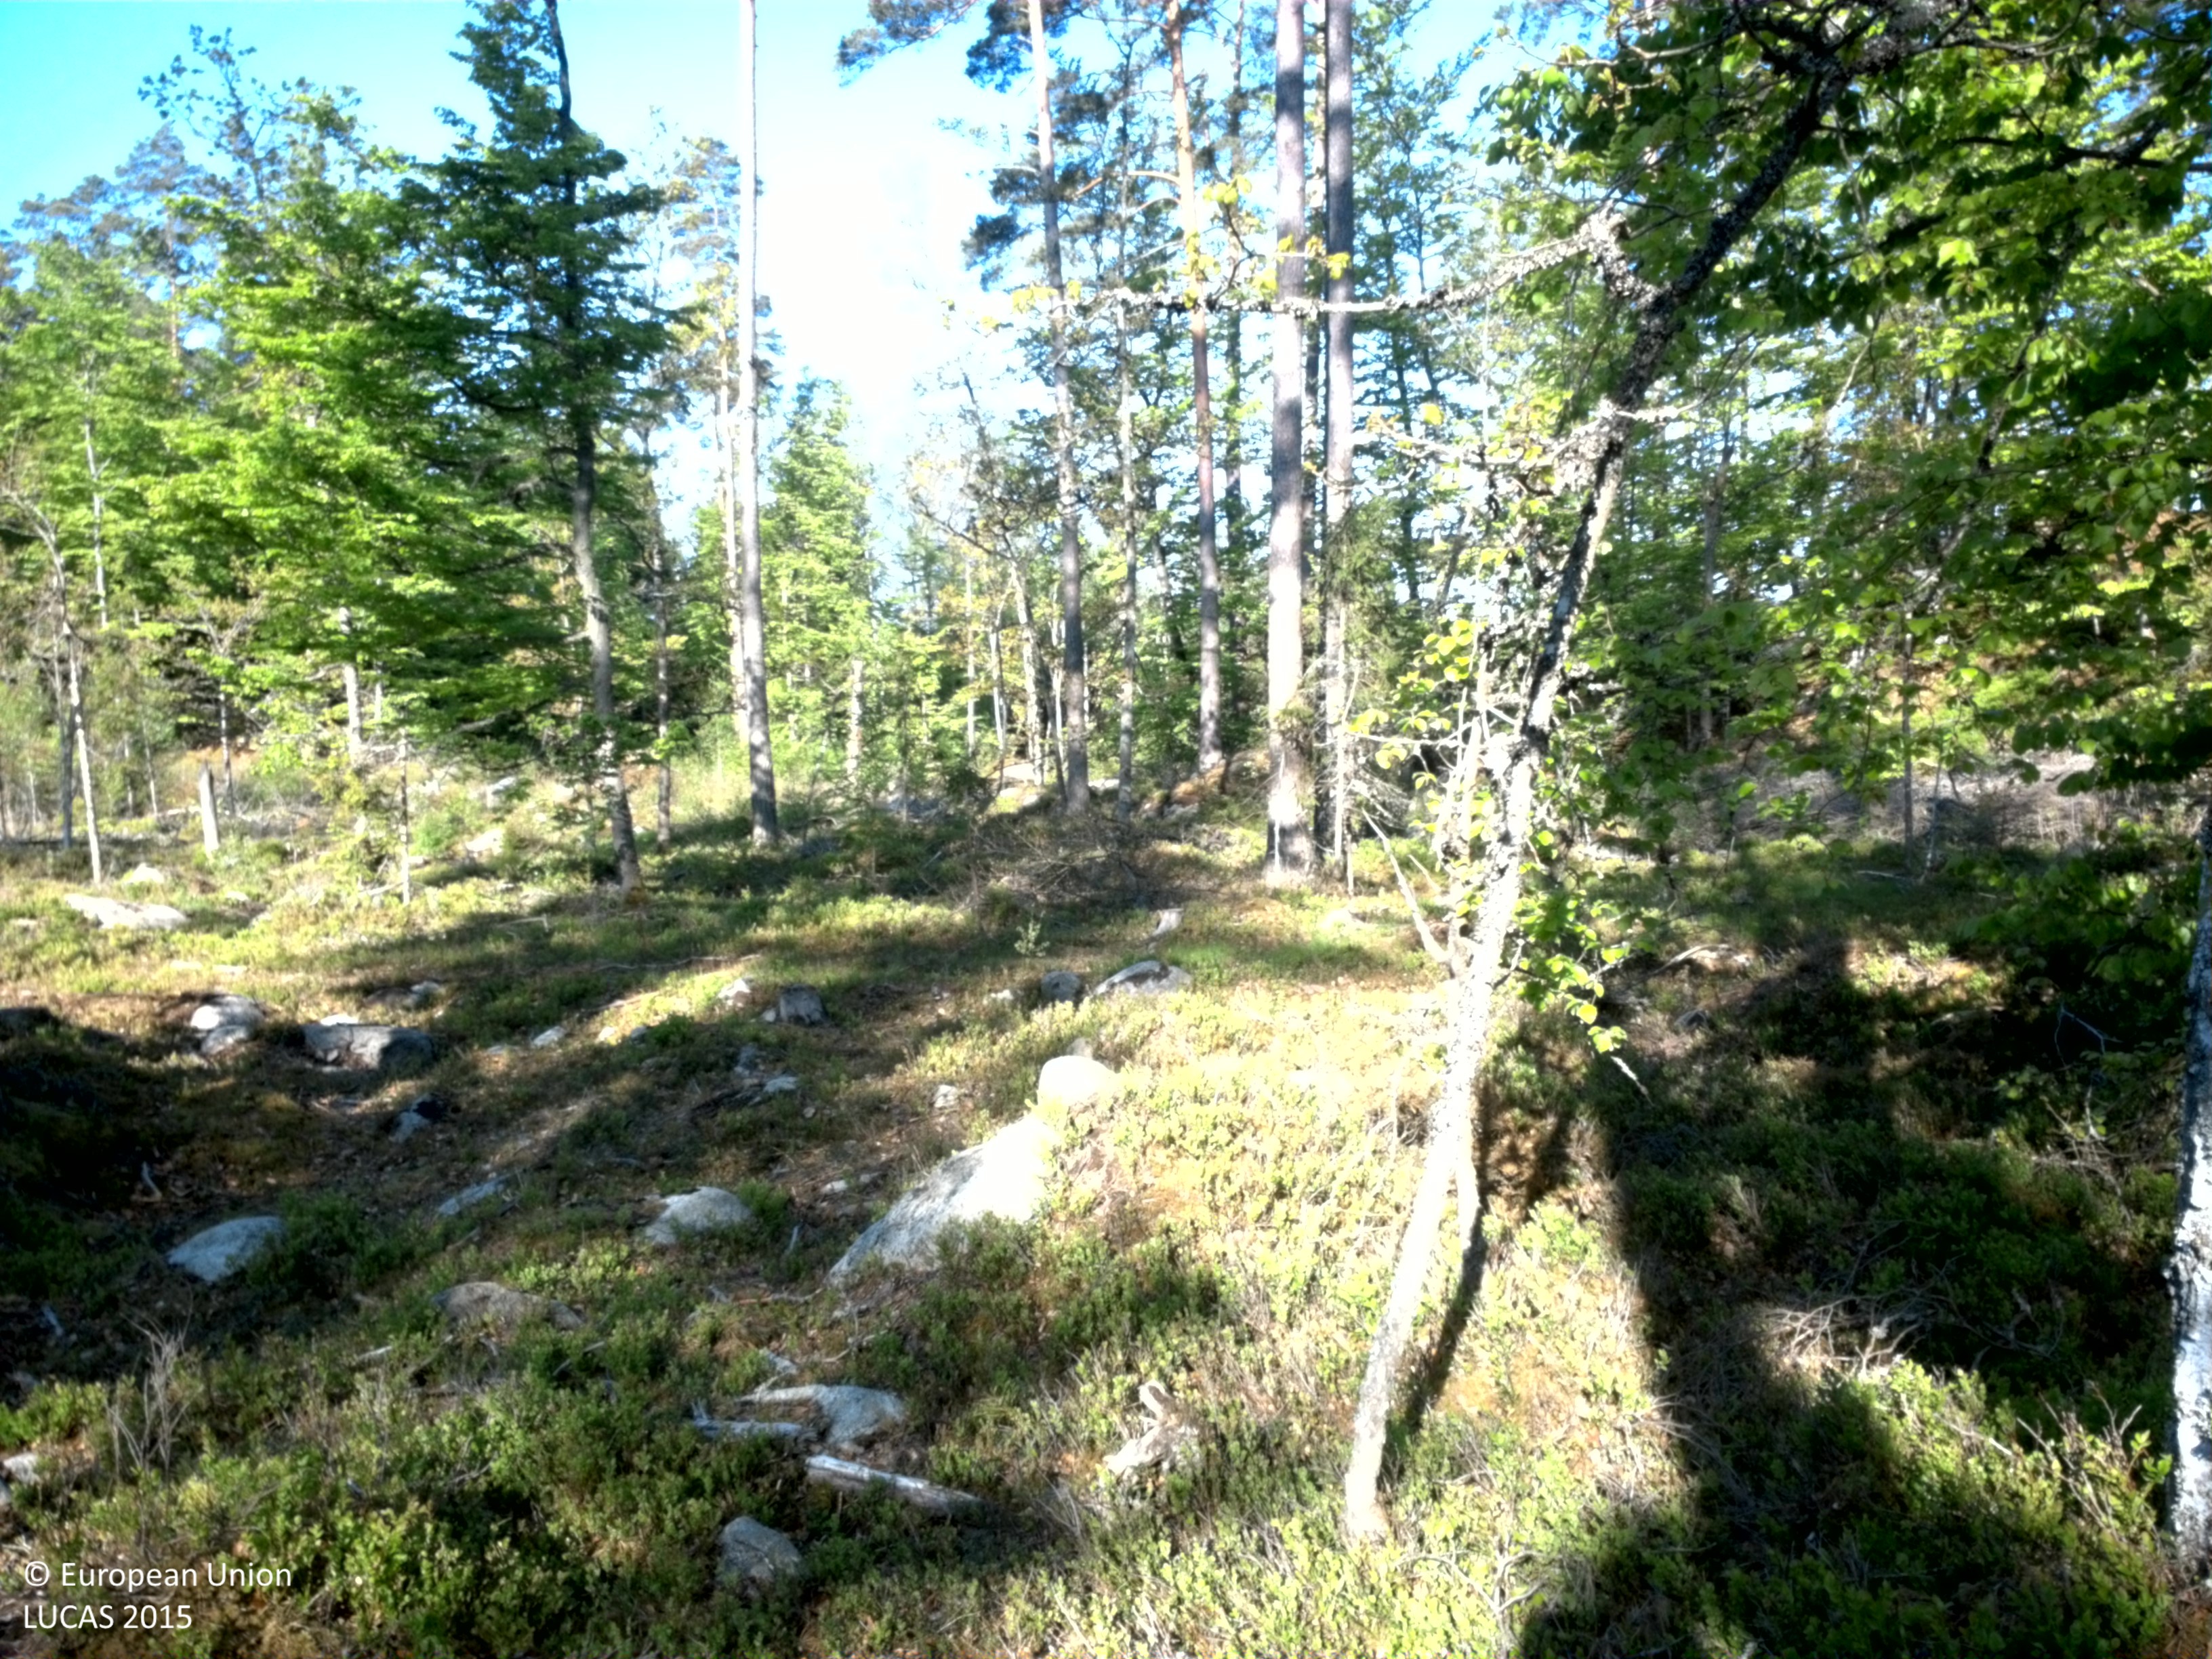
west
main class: Woodland
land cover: Pine dominated mixed woodland
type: boreal forest
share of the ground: 50 - 75 %
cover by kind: broadleaved forest trees 40 %, coniferous forest trees 30 %, shrubs 20 %, lichens and mosses 10 %
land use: Forestry
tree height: > 5 m
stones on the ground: 25 - 50 %
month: May
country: SE
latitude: 56.5735
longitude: 14.6038
